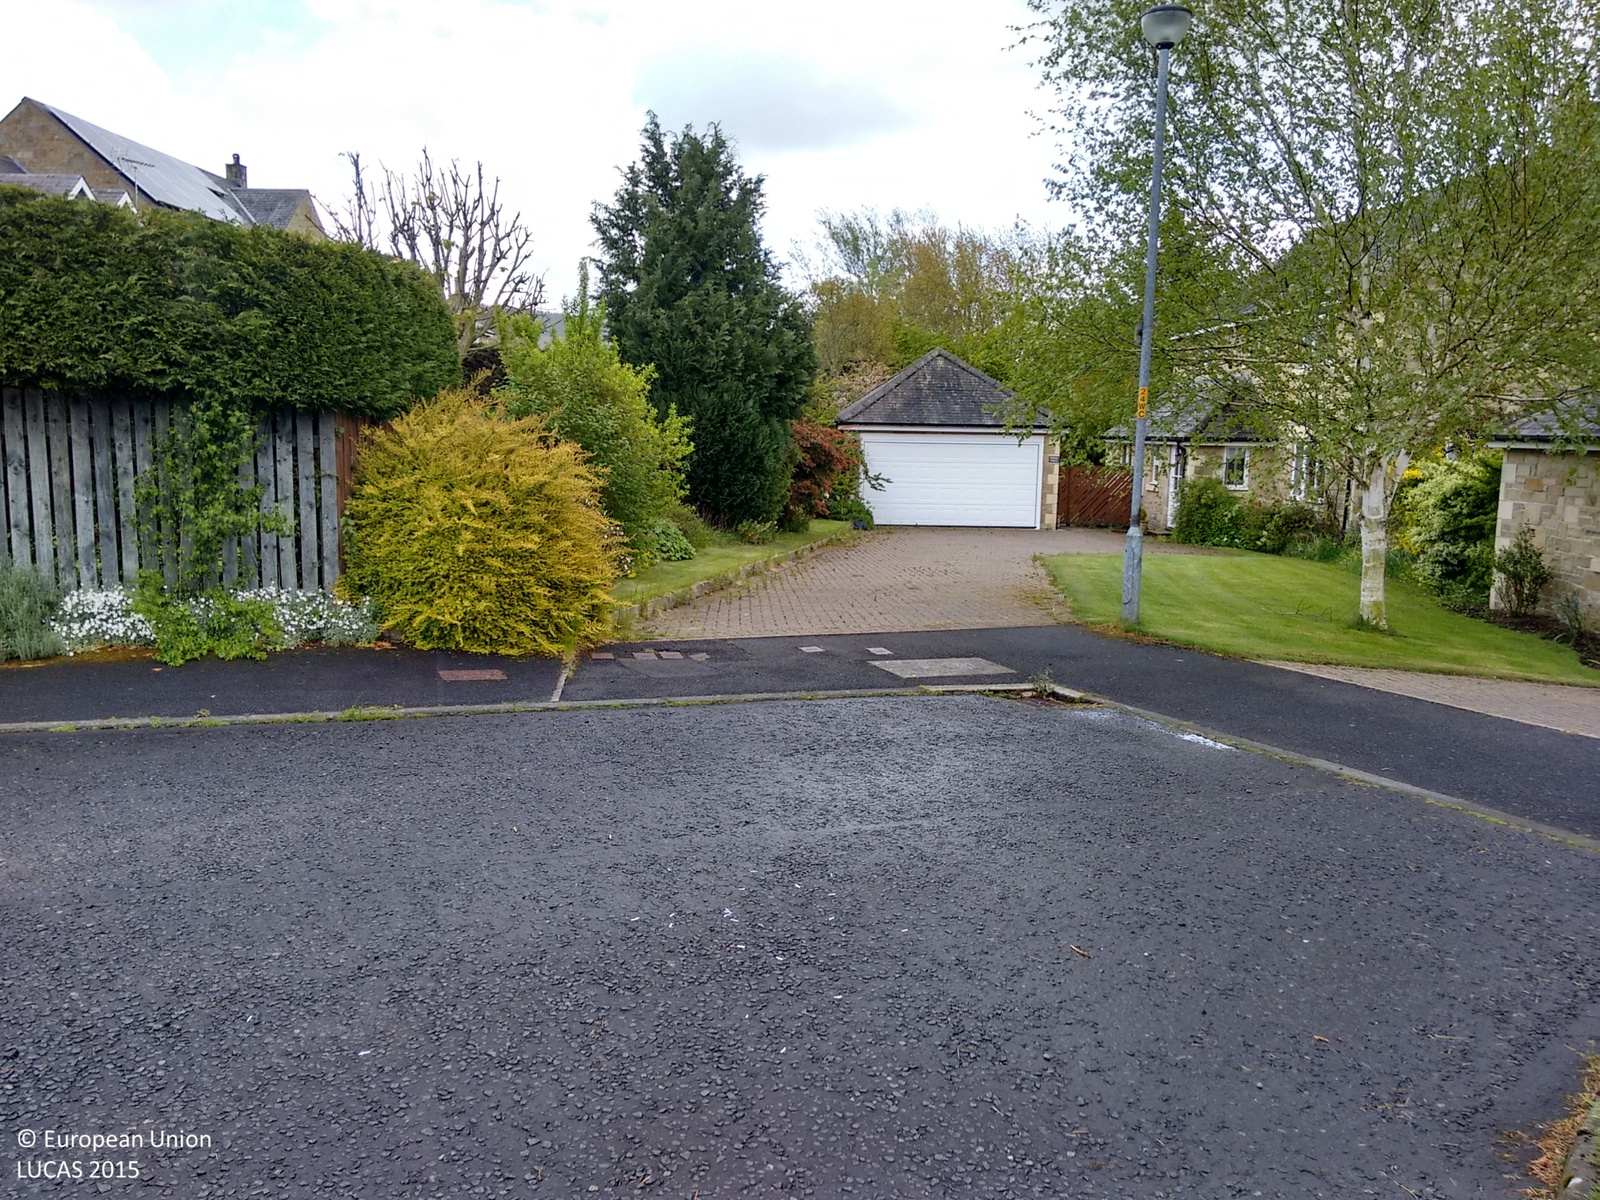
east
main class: Woodland
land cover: Spruce dominated mixed woodland
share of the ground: 50 - 75 %
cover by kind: coniferous forest trees 25 %, broadleaved forest trees 25 %, herbaceous plants 10 %
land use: Residential
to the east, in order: Spruce dominated mixed woodland; Artificial constructions in urban areas; Grassland with sparse tree/shrub cover; Arable land (only in case pi)
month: May
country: GB
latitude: 55.0048
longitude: -2.1743
